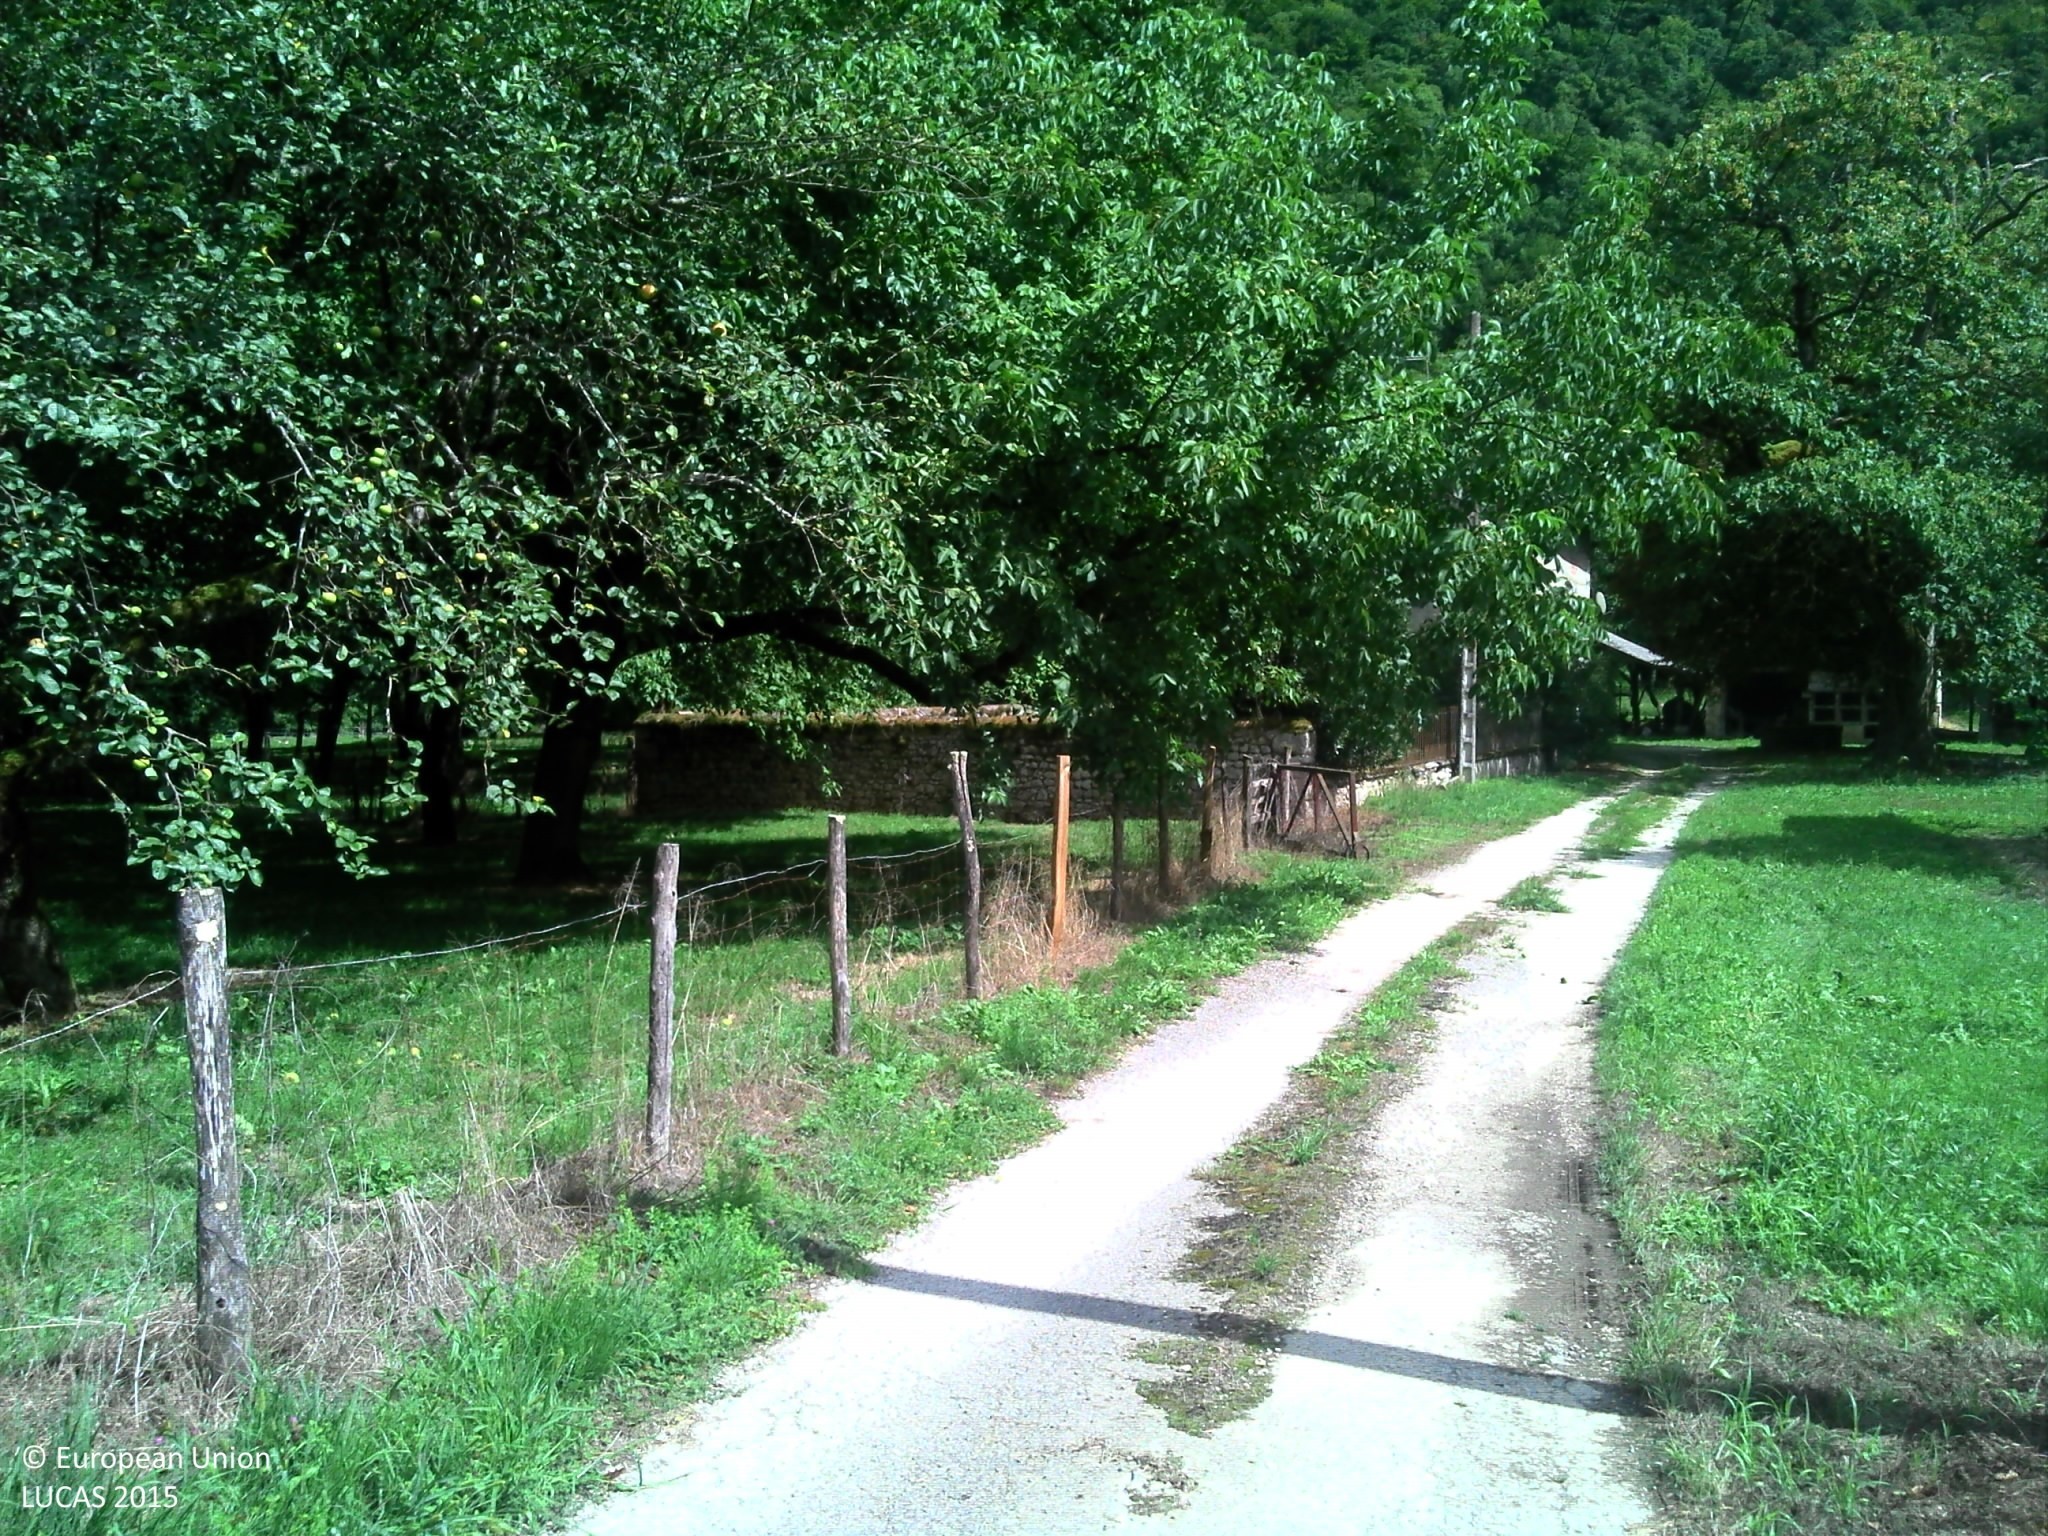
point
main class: Grassland
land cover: Grassland with sparse tree/shrub cover
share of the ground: > 75 %
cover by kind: herbaceous plants 80 %, unconsolidated bare surface 15 %, broadleaved forest trees 5 %
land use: Residential
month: August
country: FR
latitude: 45.2655
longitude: 5.5317
